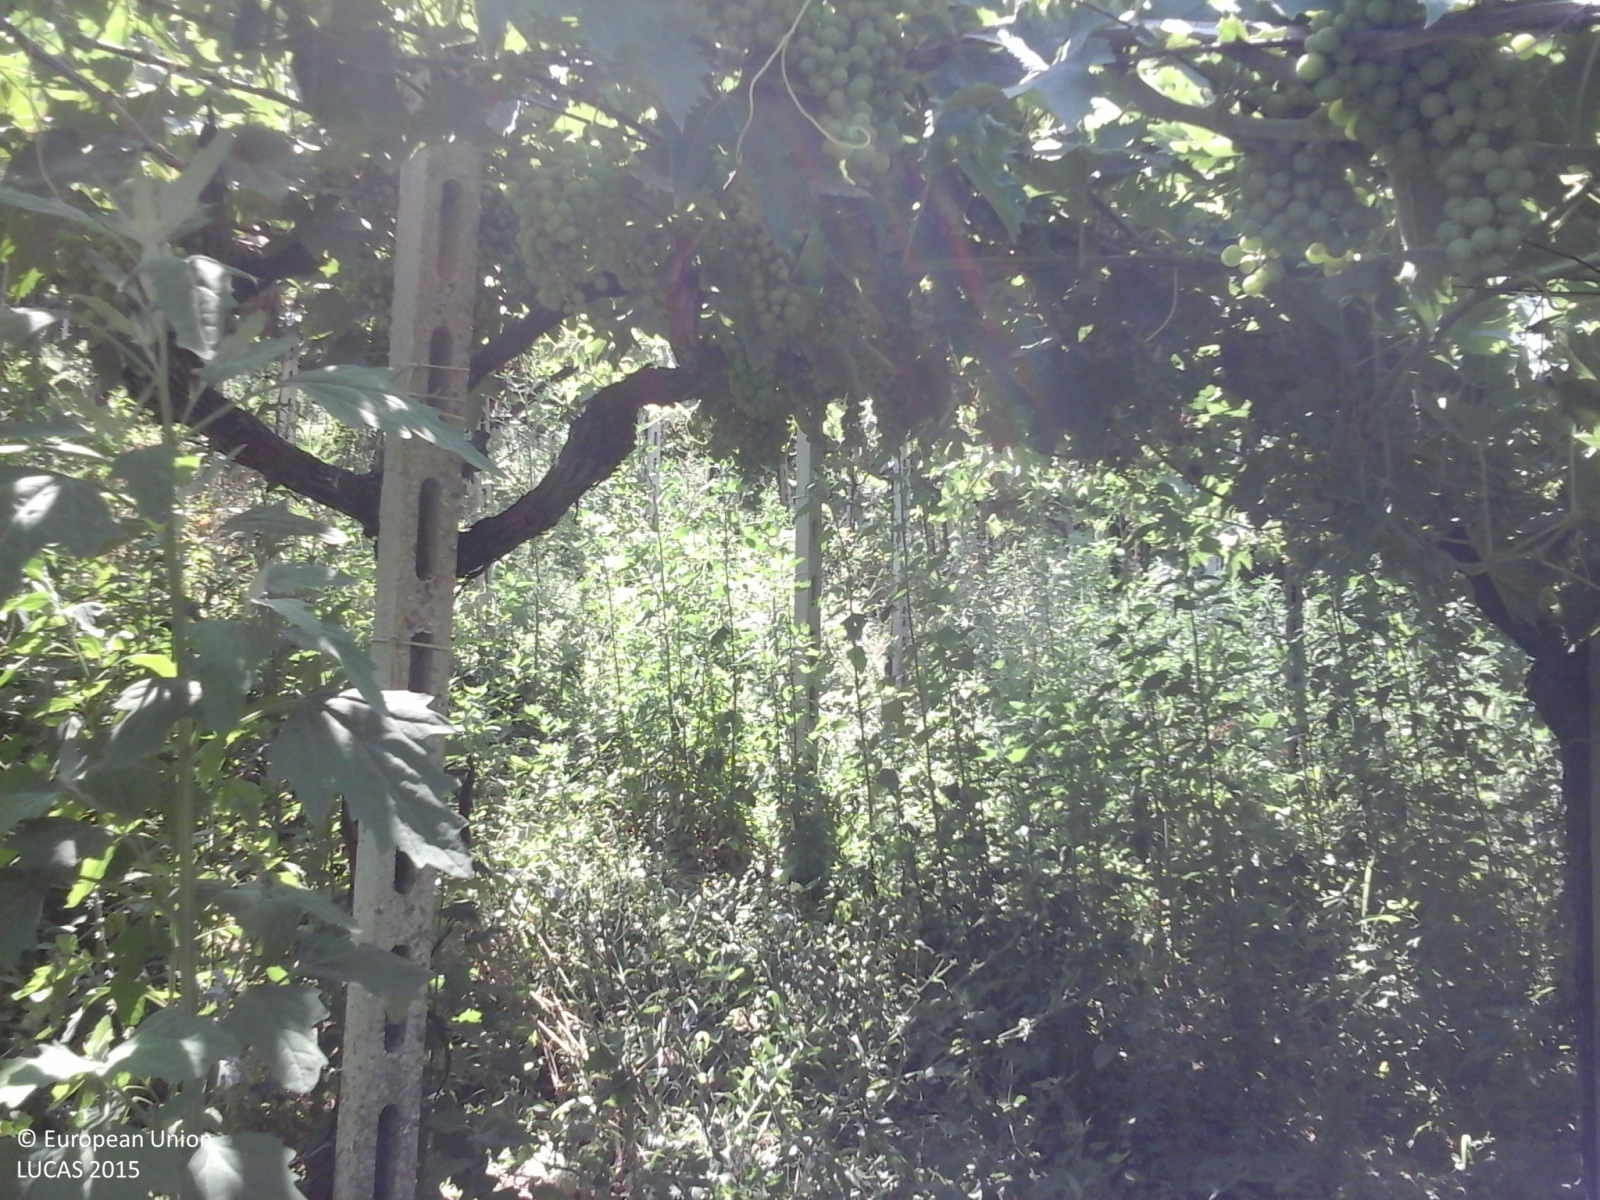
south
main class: Cropland
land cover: Vineyards
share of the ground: 25 - 50 %
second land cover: Spontaneously vegetated surfaces
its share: 25 - 50 %
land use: Agriculture (excluding fallow land and kitchen gardens)
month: July
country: IT
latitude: 42.3118
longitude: 14.2455
